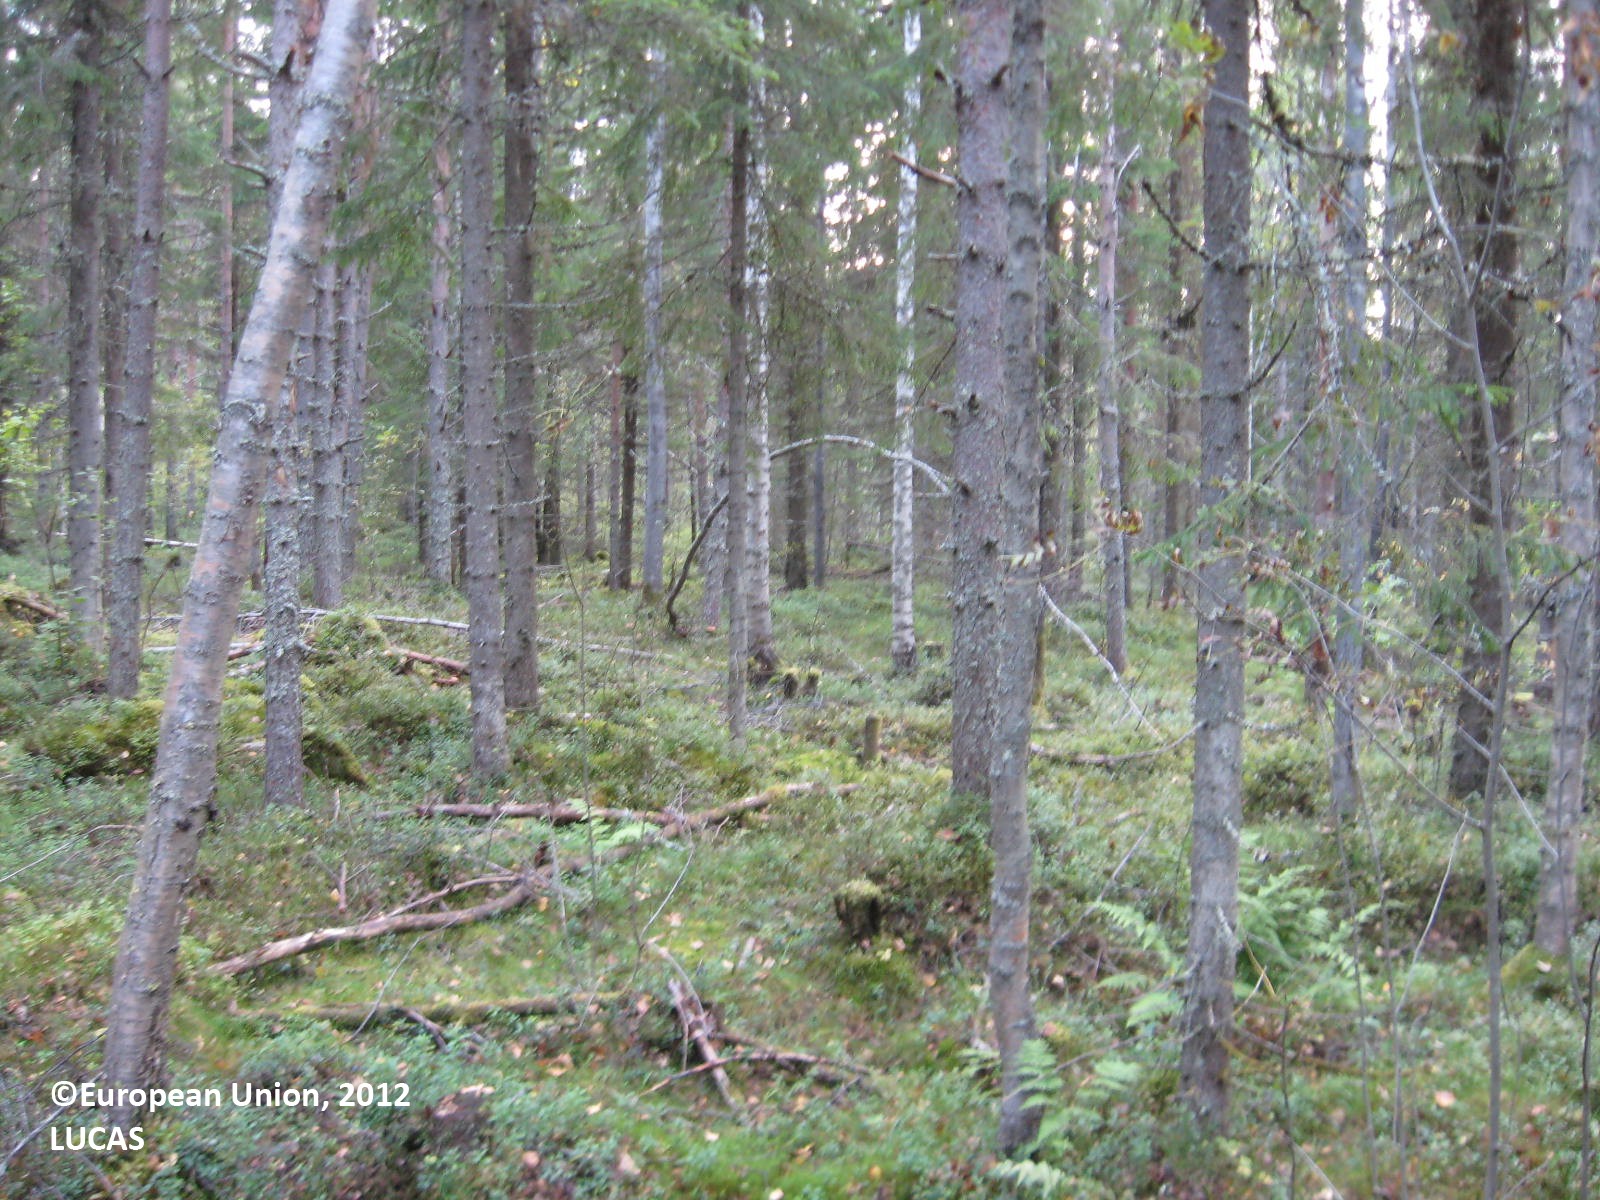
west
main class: Woodland
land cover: Spruce dominated mixed woodland
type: boreal forest
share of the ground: > 75 %
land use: Forestry
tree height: > 5 m
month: August
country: FI
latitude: 63.7319
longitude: 29.4832
